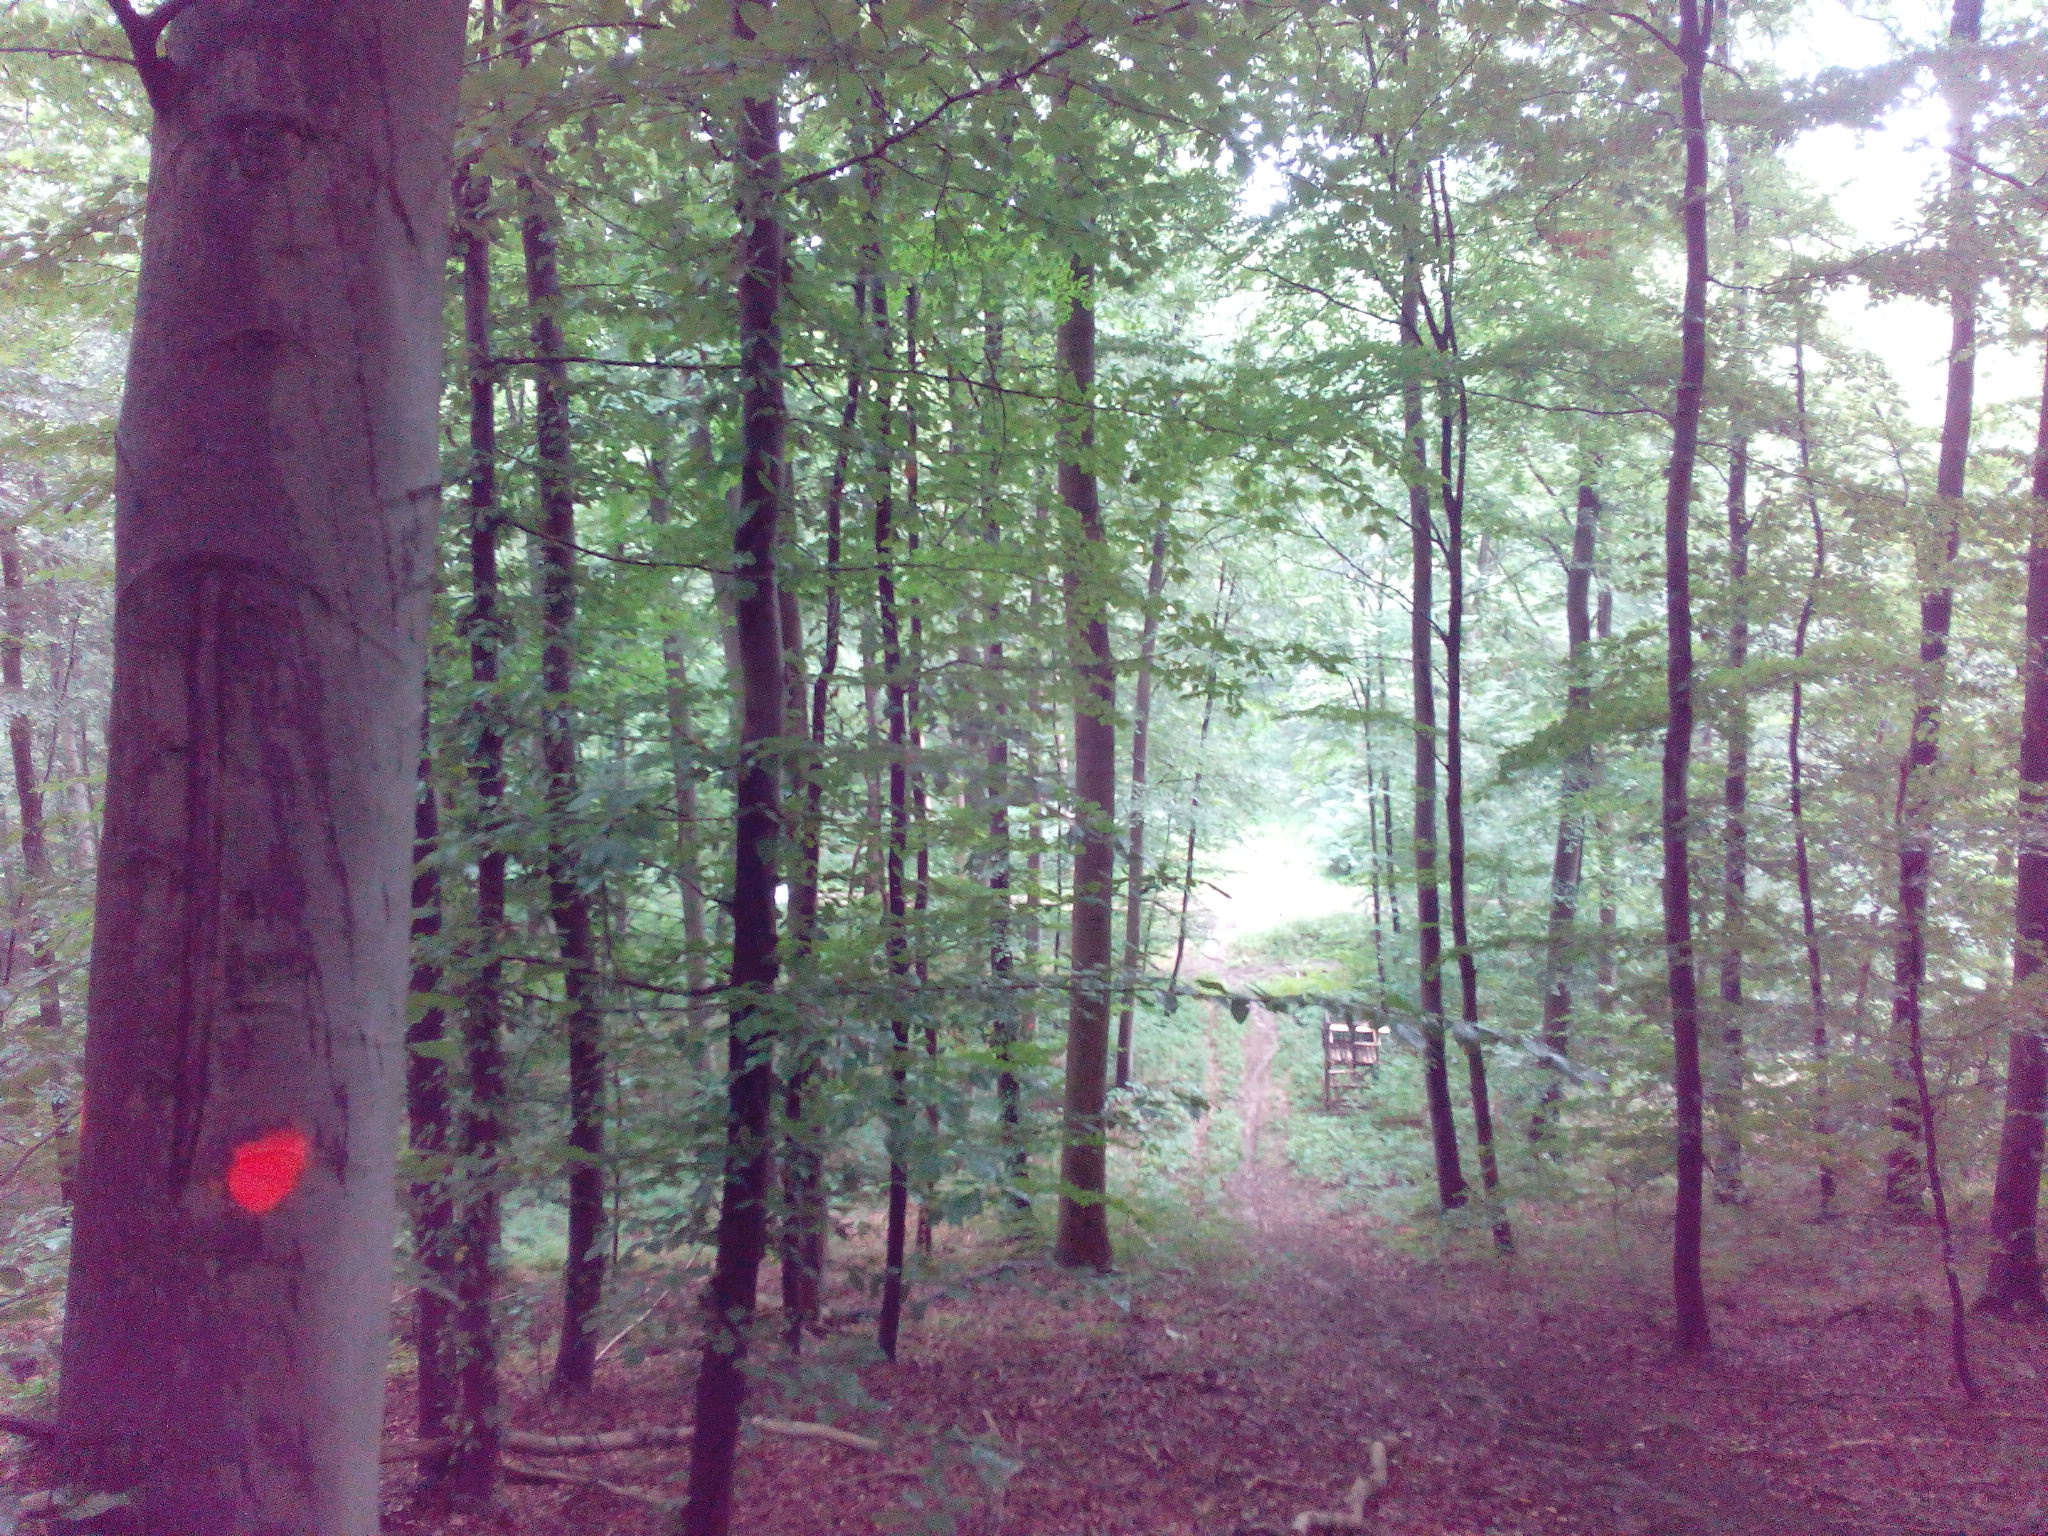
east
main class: Woodland
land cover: Broadleaved woodland
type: mesophytic deciduous forest
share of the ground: > 75 %
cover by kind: broadleaved forest trees 90 %, herbaceous plants 10 %
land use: Forestry
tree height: > 5 m
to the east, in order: Broadleaved woodland; Tracks; Broadleaved woodland; Tracks; Broadleaved woodland
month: August
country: DE
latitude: 52.1437
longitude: 9.8977
